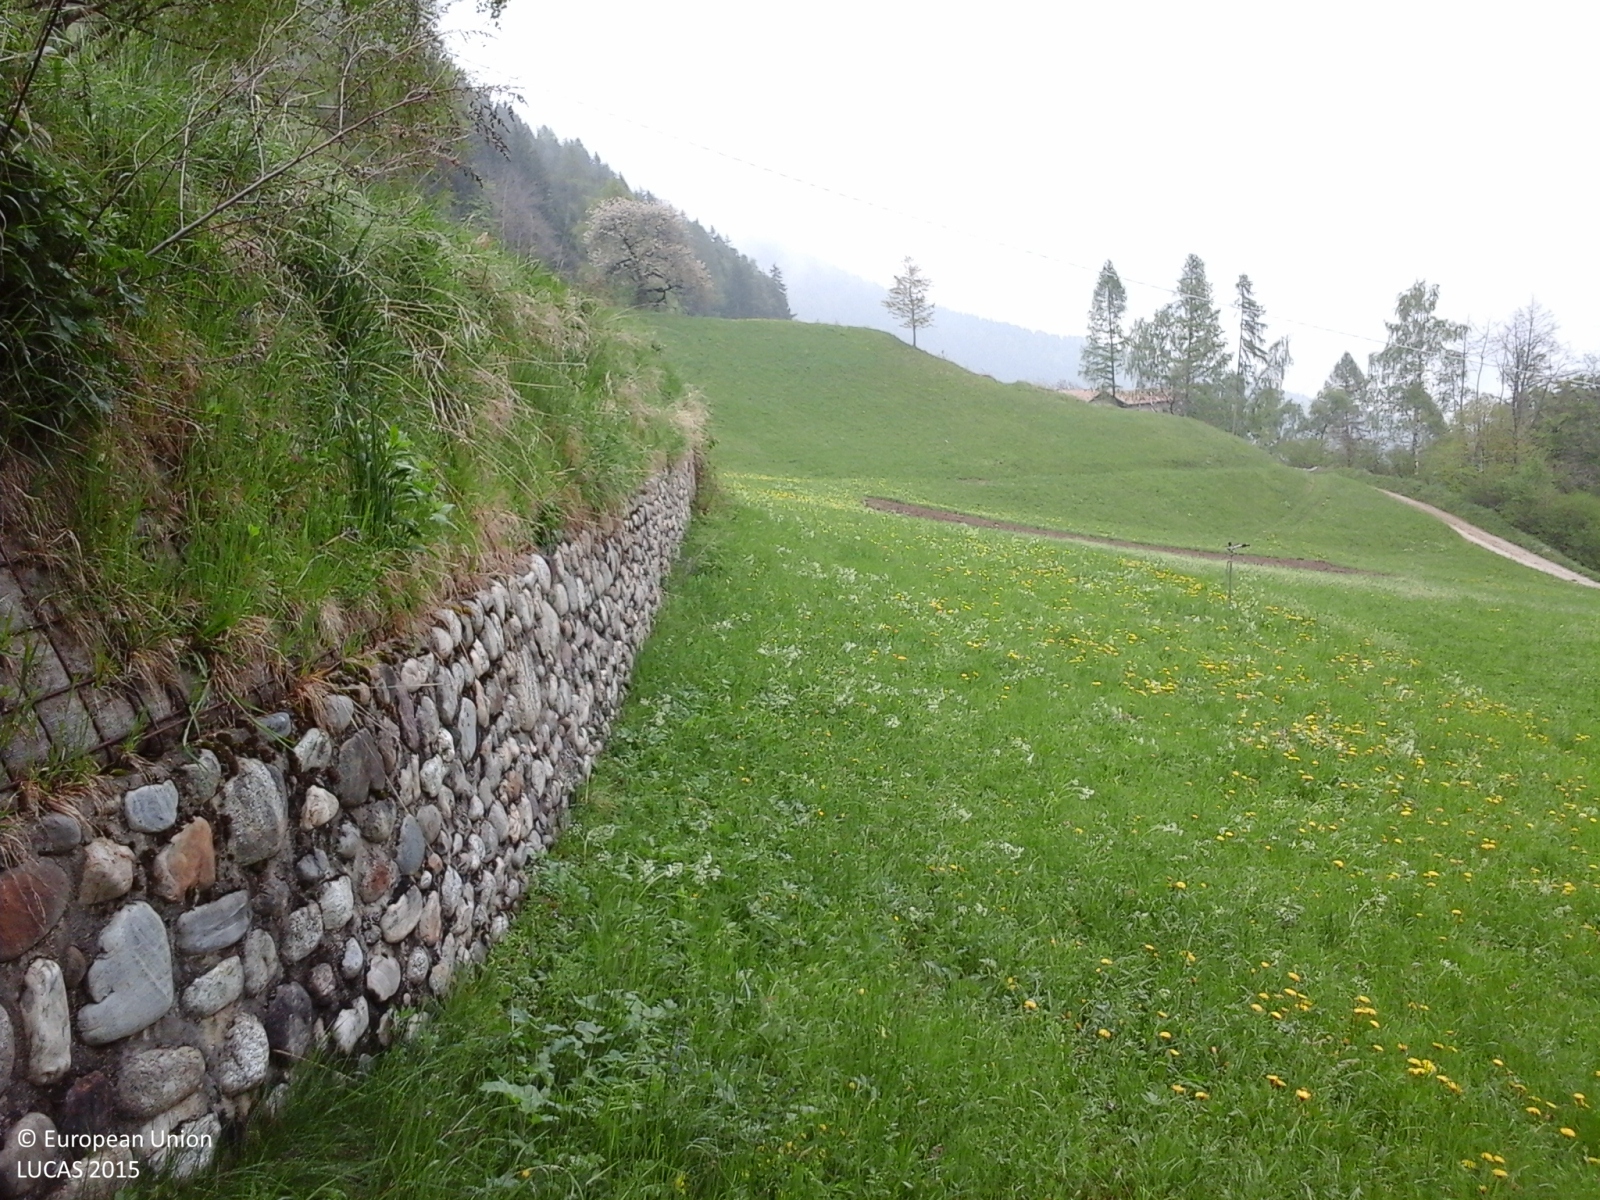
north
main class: Grassland
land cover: Grassland without tree/shrub cover
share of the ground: > 75 %
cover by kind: herbaceous plants 100 %
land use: Agriculture (excluding fallow land and kitchen gardens)
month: May
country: IT
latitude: 46.5433
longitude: 11.1332
